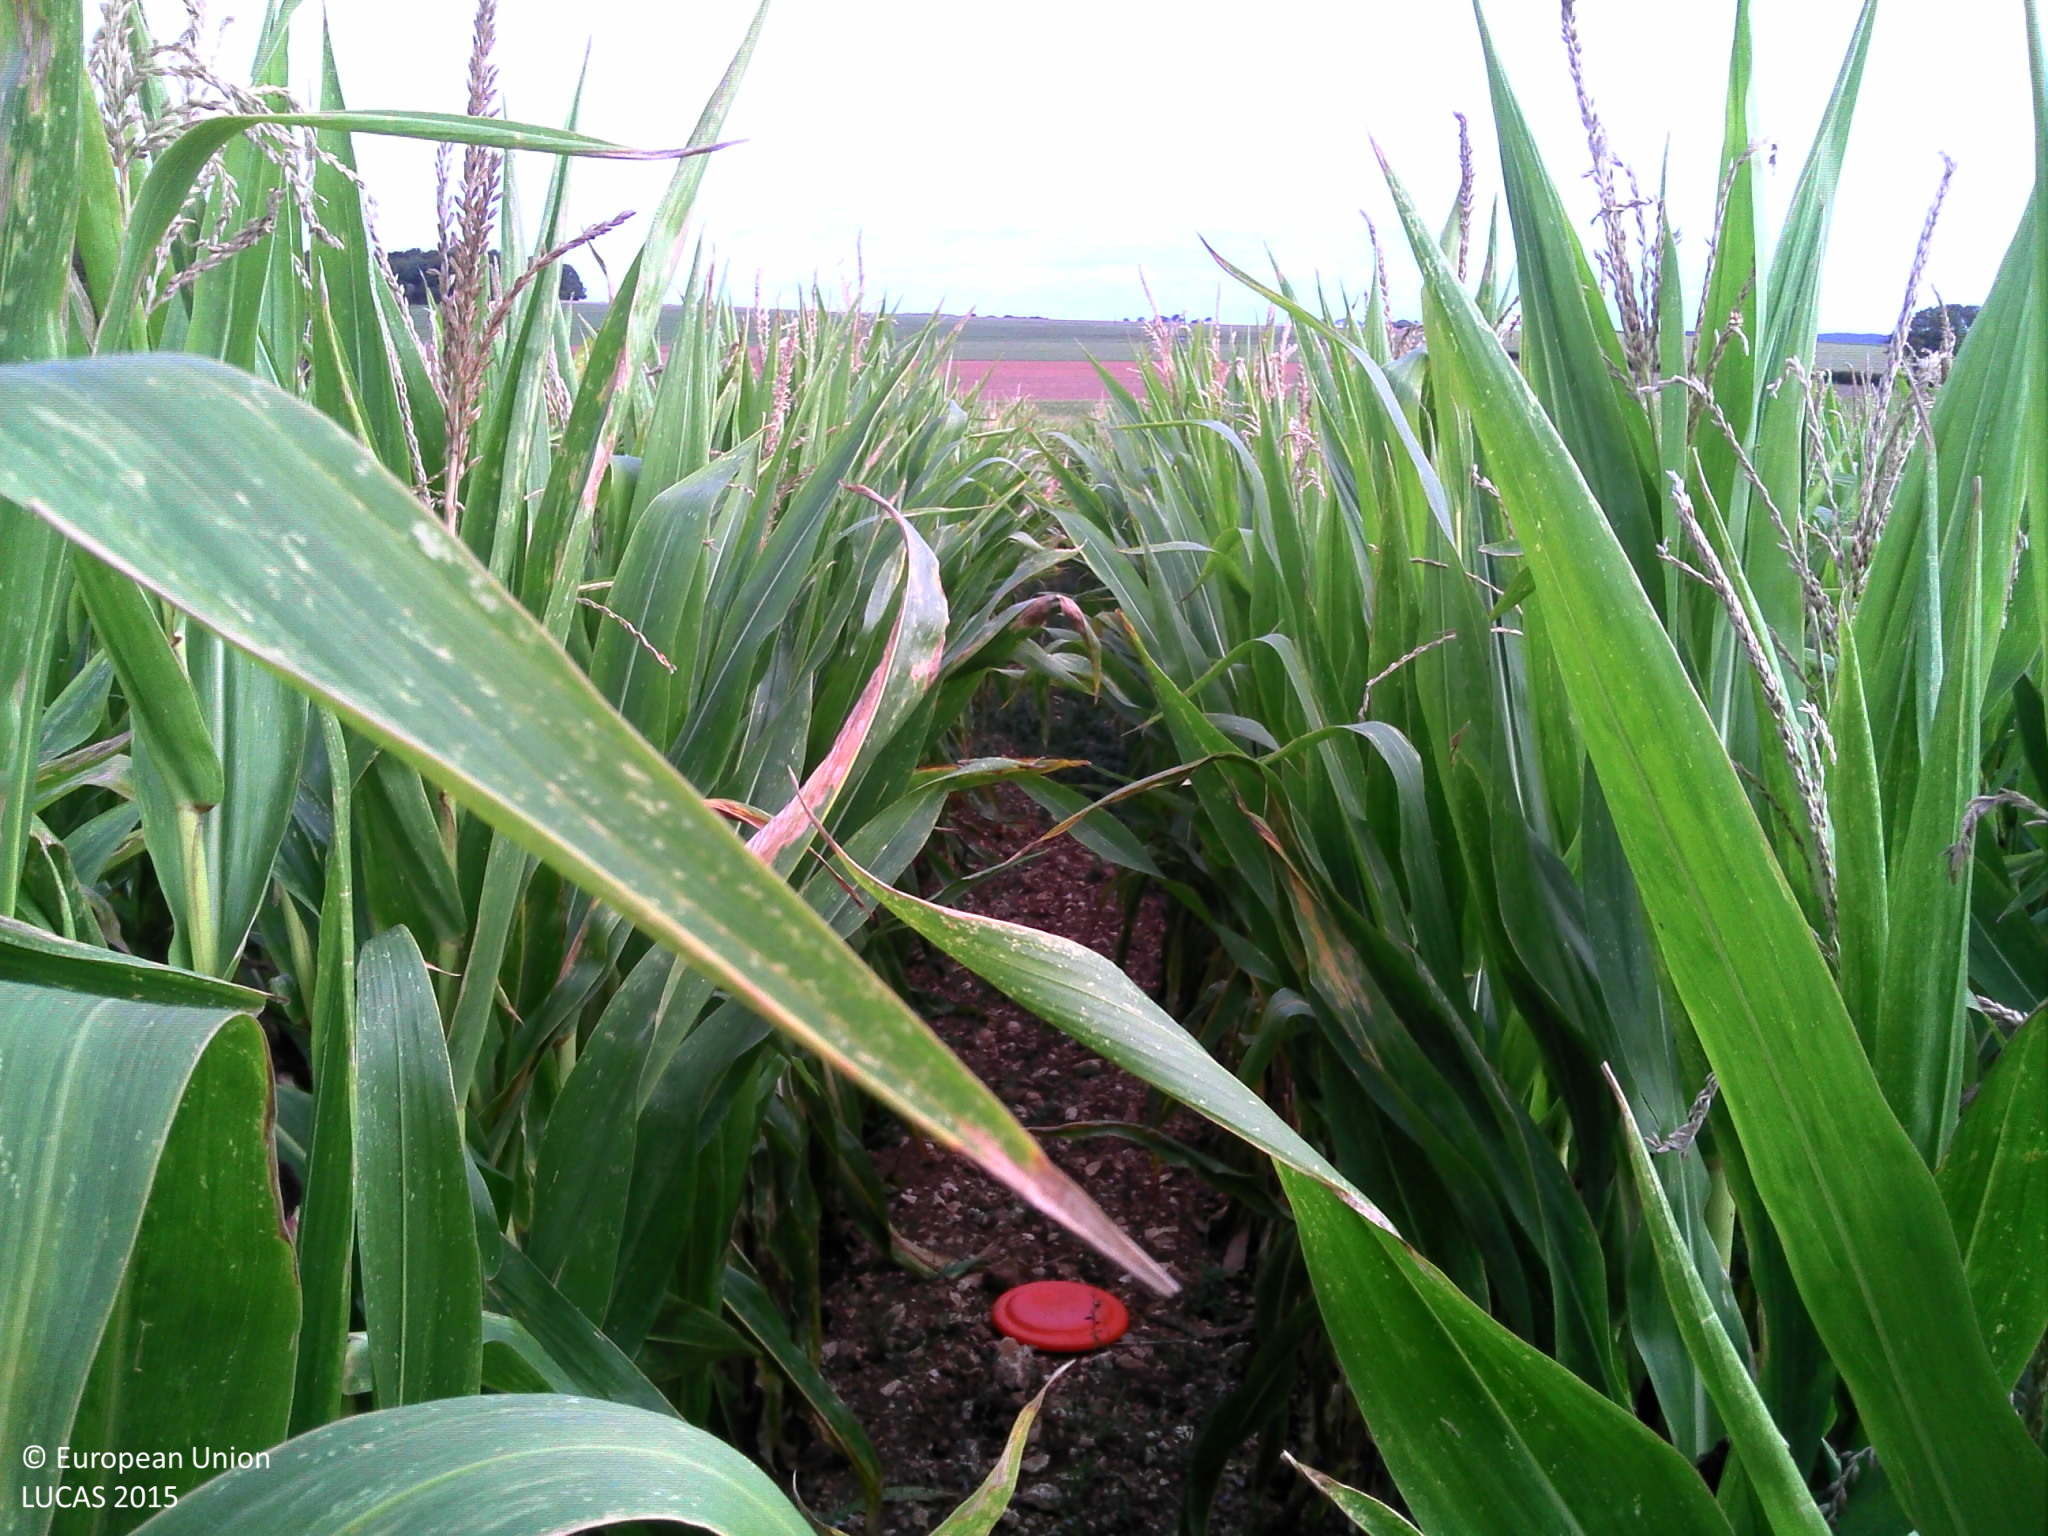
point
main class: Cropland
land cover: Maize
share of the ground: > 75 %
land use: Agriculture (excluding fallow land and kitchen gardens)
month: August
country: FR
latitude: 47.6702
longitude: 4.8453
